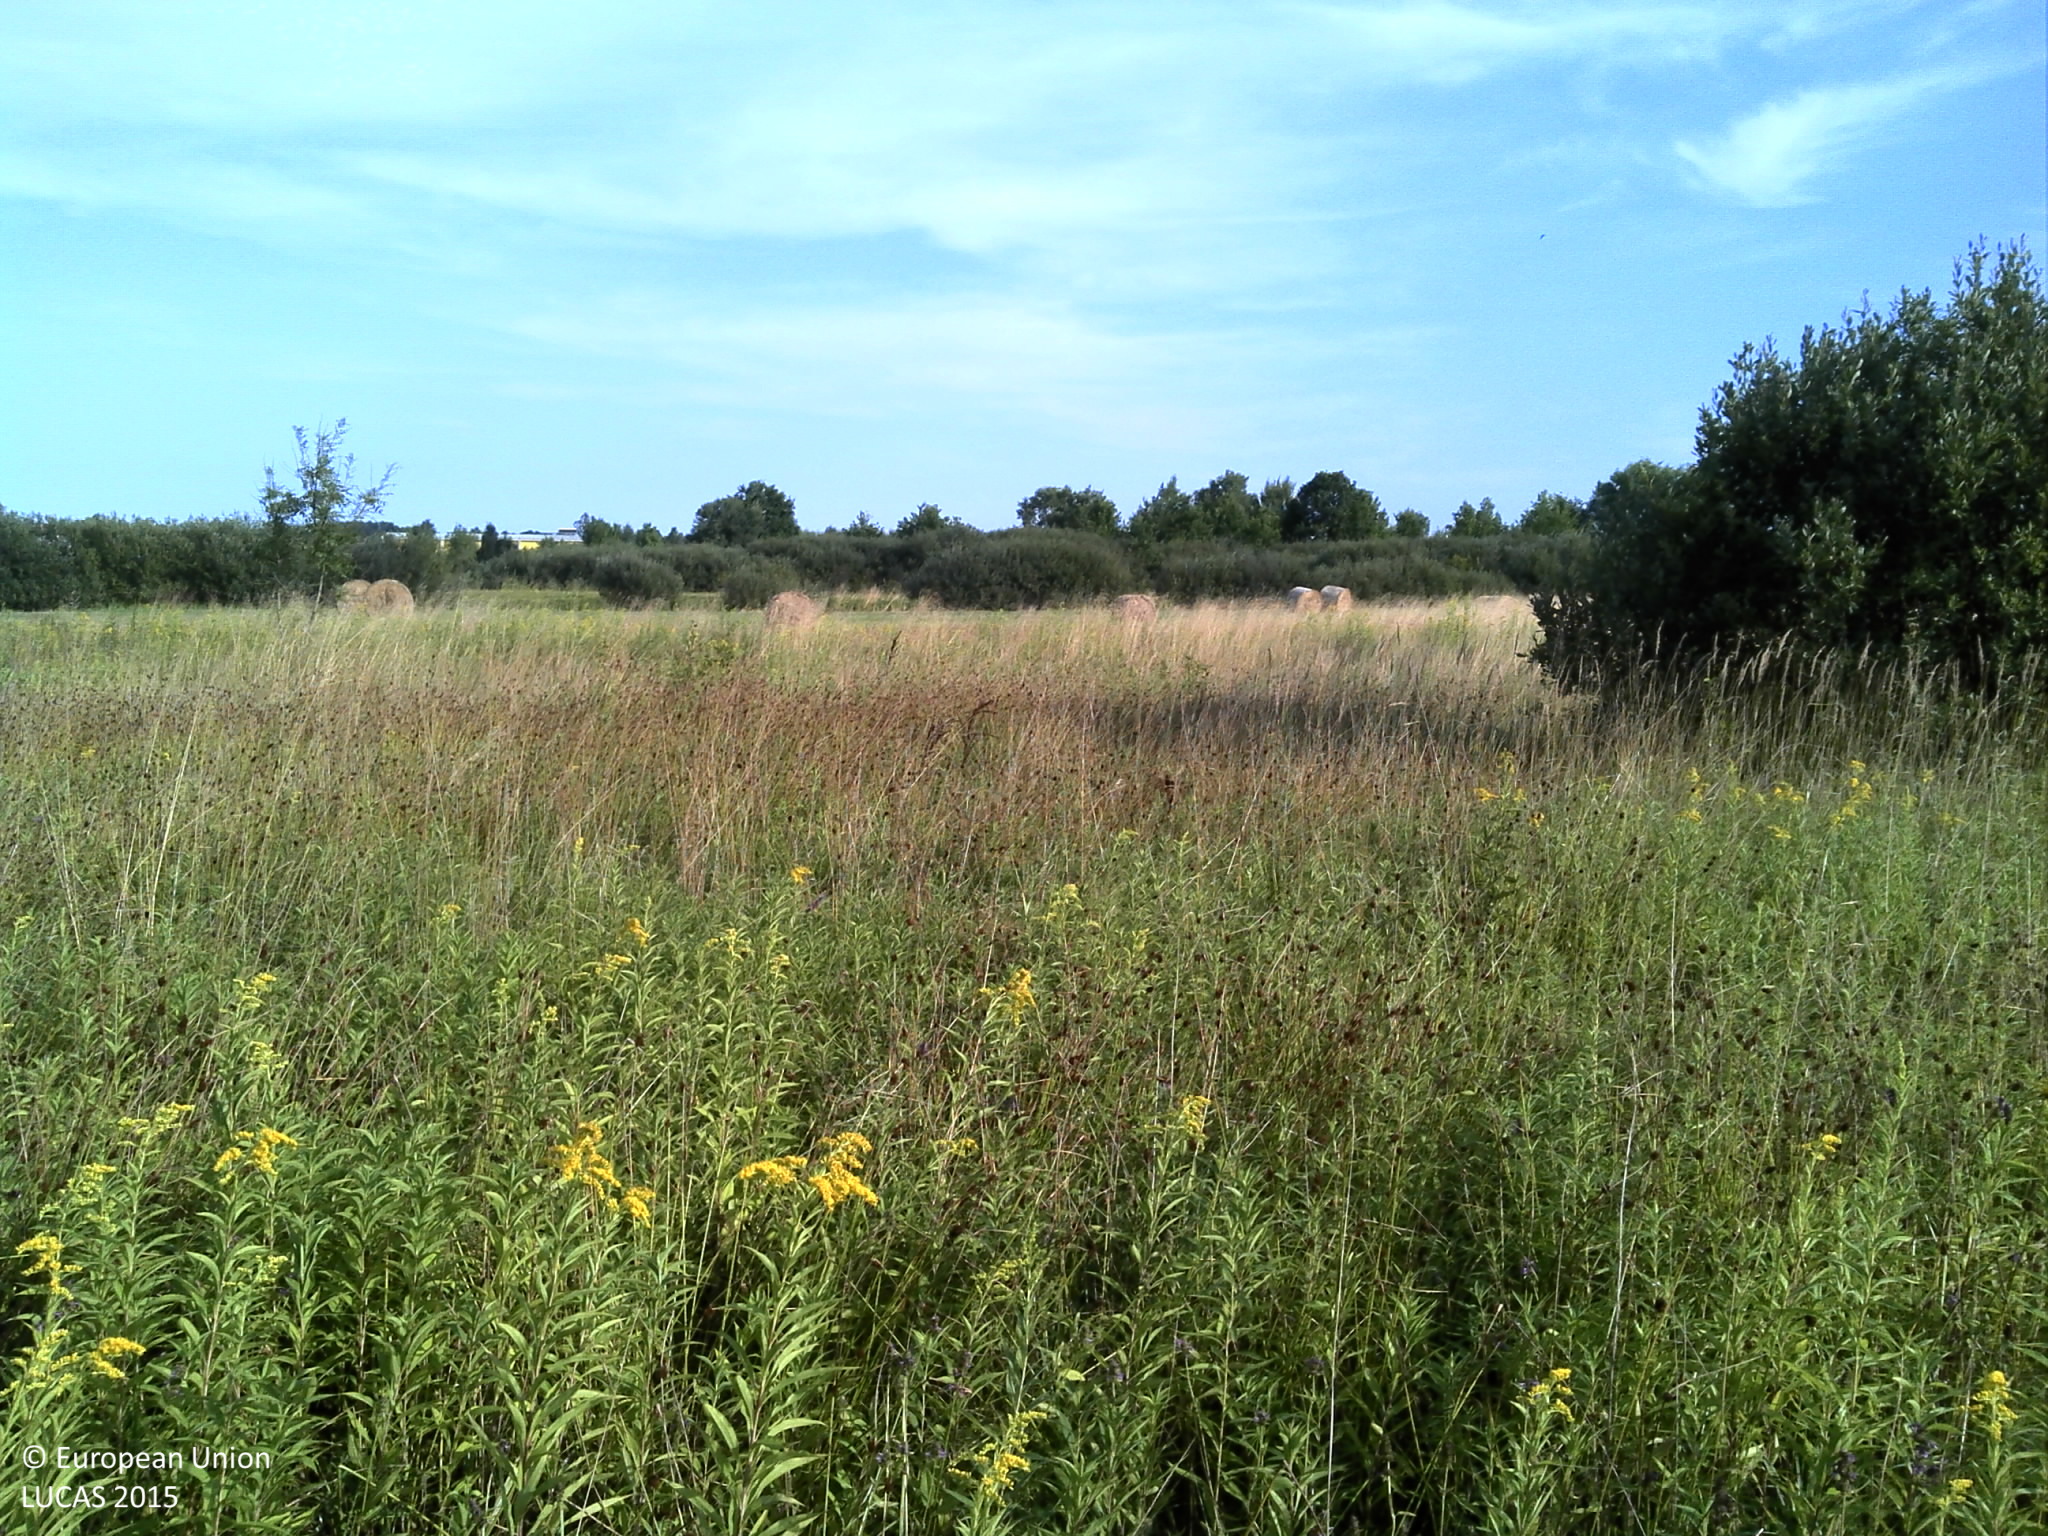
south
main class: Grassland
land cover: Grassland without tree/shrub cover
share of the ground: > 75 %
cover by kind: herbaceous plants 100 %
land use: Agriculture (excluding fallow land and kitchen gardens)
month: July
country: HR
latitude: 45.6066
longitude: 16.5764
